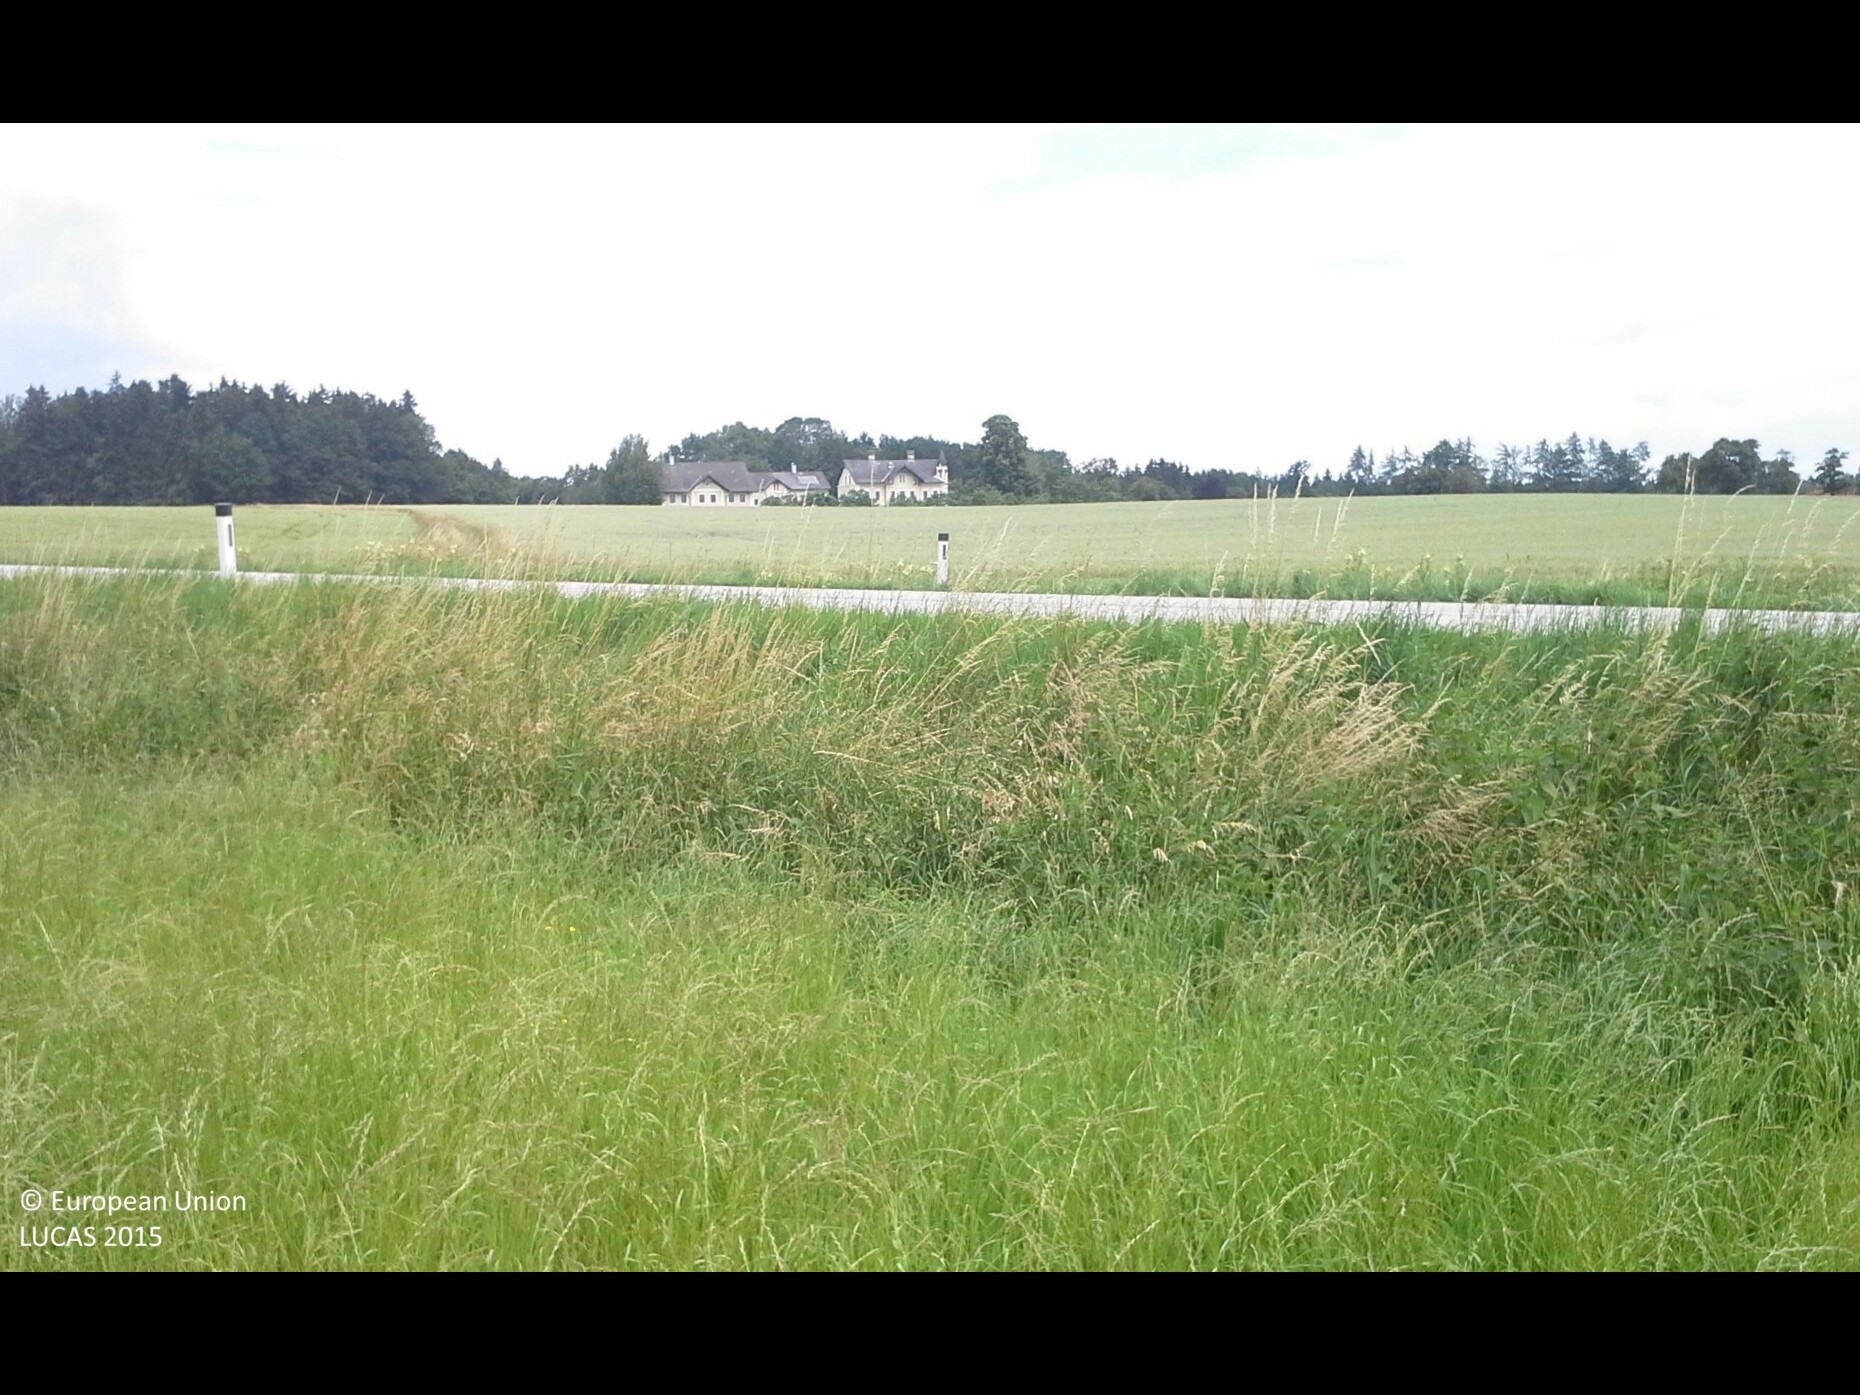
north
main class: Grassland
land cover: Grassland with sparse tree/shrub cover
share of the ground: > 75 %
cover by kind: herbaceous plants 95 %, broadleaved forest trees 5 %
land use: Agriculture (excluding fallow land and kitchen gardens)
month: June
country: AT
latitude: 48.0565
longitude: 14.5755
